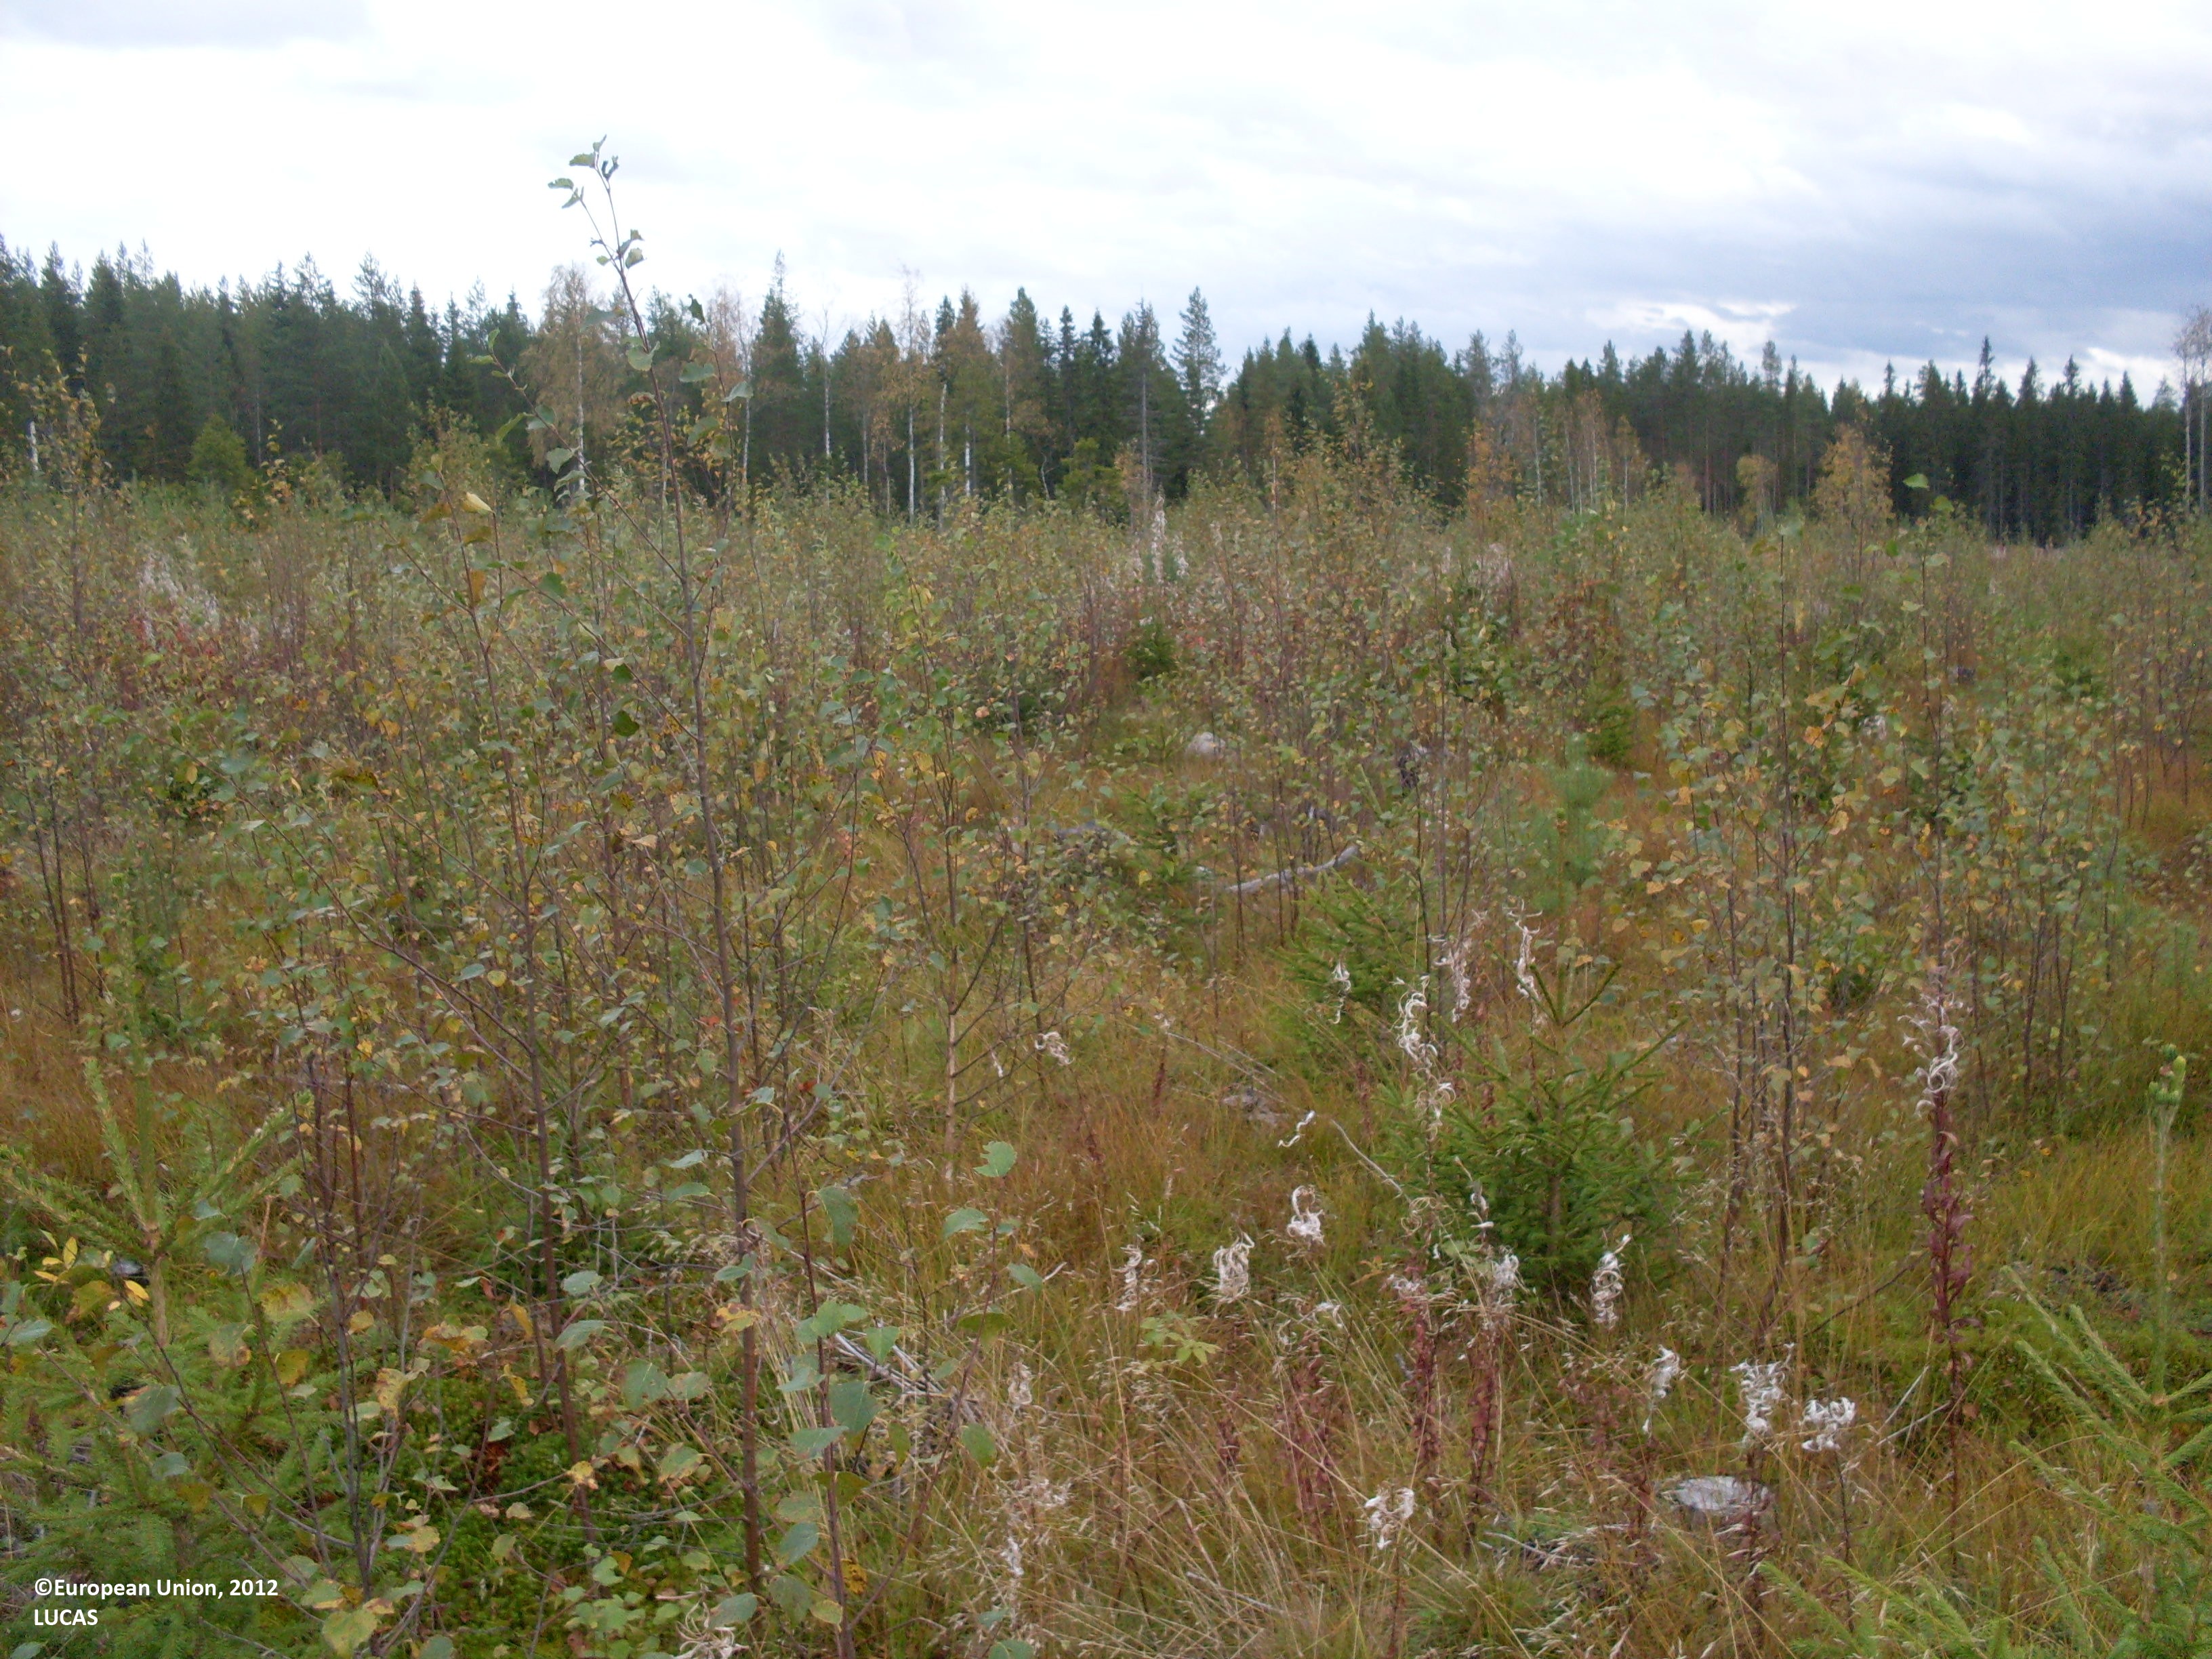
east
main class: Woodland
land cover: Pine dominated mixed woodland
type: boreal forest
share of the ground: 25 - 50 %
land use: Forestry
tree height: < 5 m
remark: Nursery
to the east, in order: Pine dominated mixed woodland
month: September
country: FI
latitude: 64.2807
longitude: 28.3700
